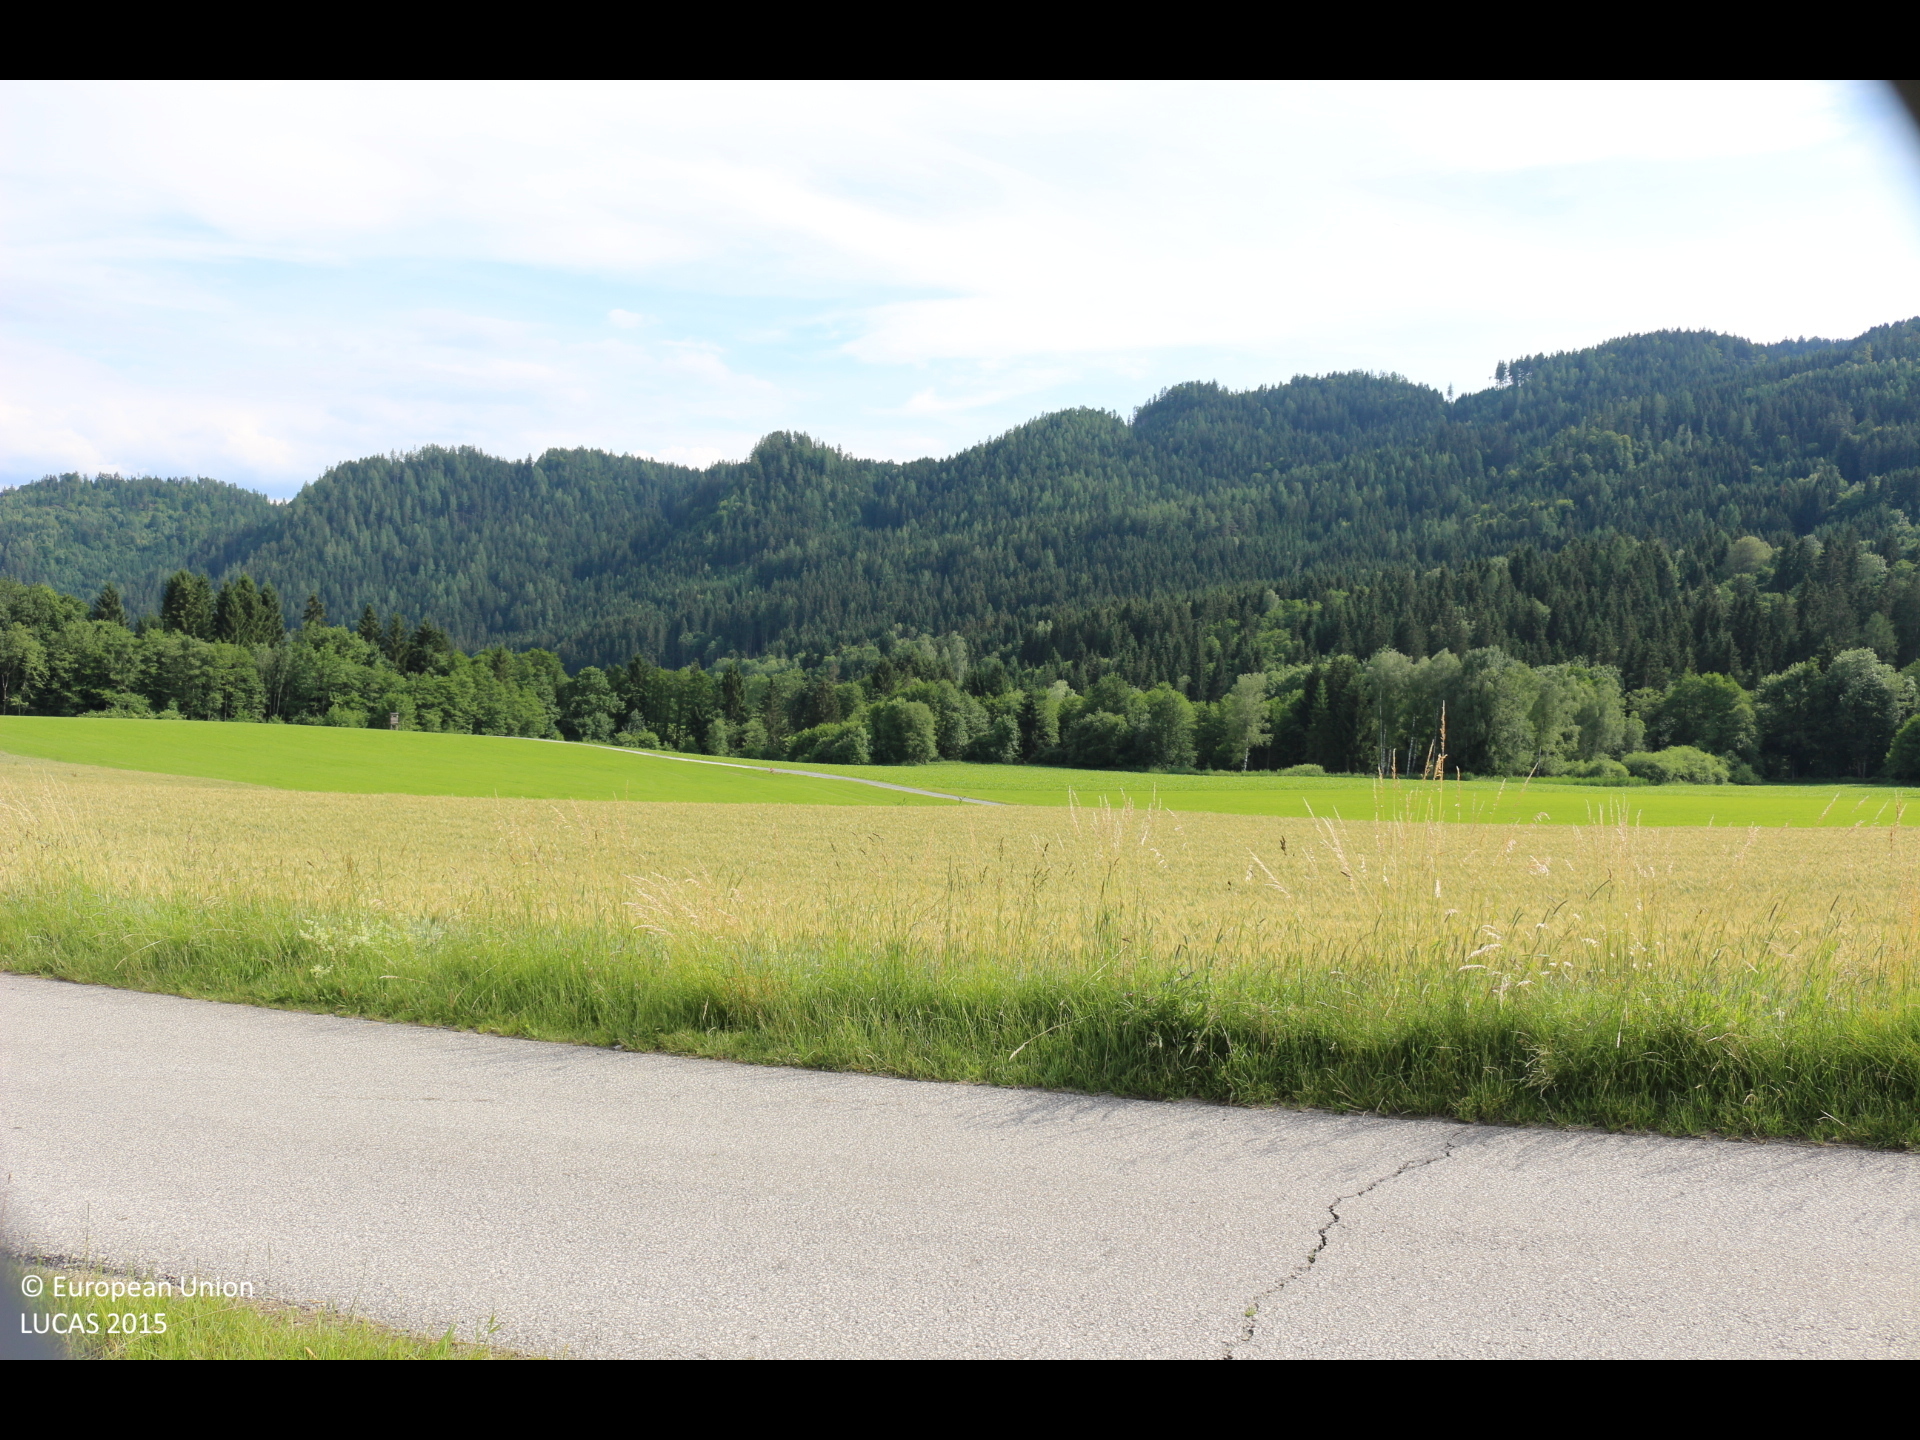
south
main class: Grassland
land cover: Grassland without tree/shrub cover
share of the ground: > 75 %
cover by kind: herbaceous plants 100 %
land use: Agriculture (excluding fallow land and kitchen gardens)
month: June
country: AT
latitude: 46.7257
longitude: 14.0406
